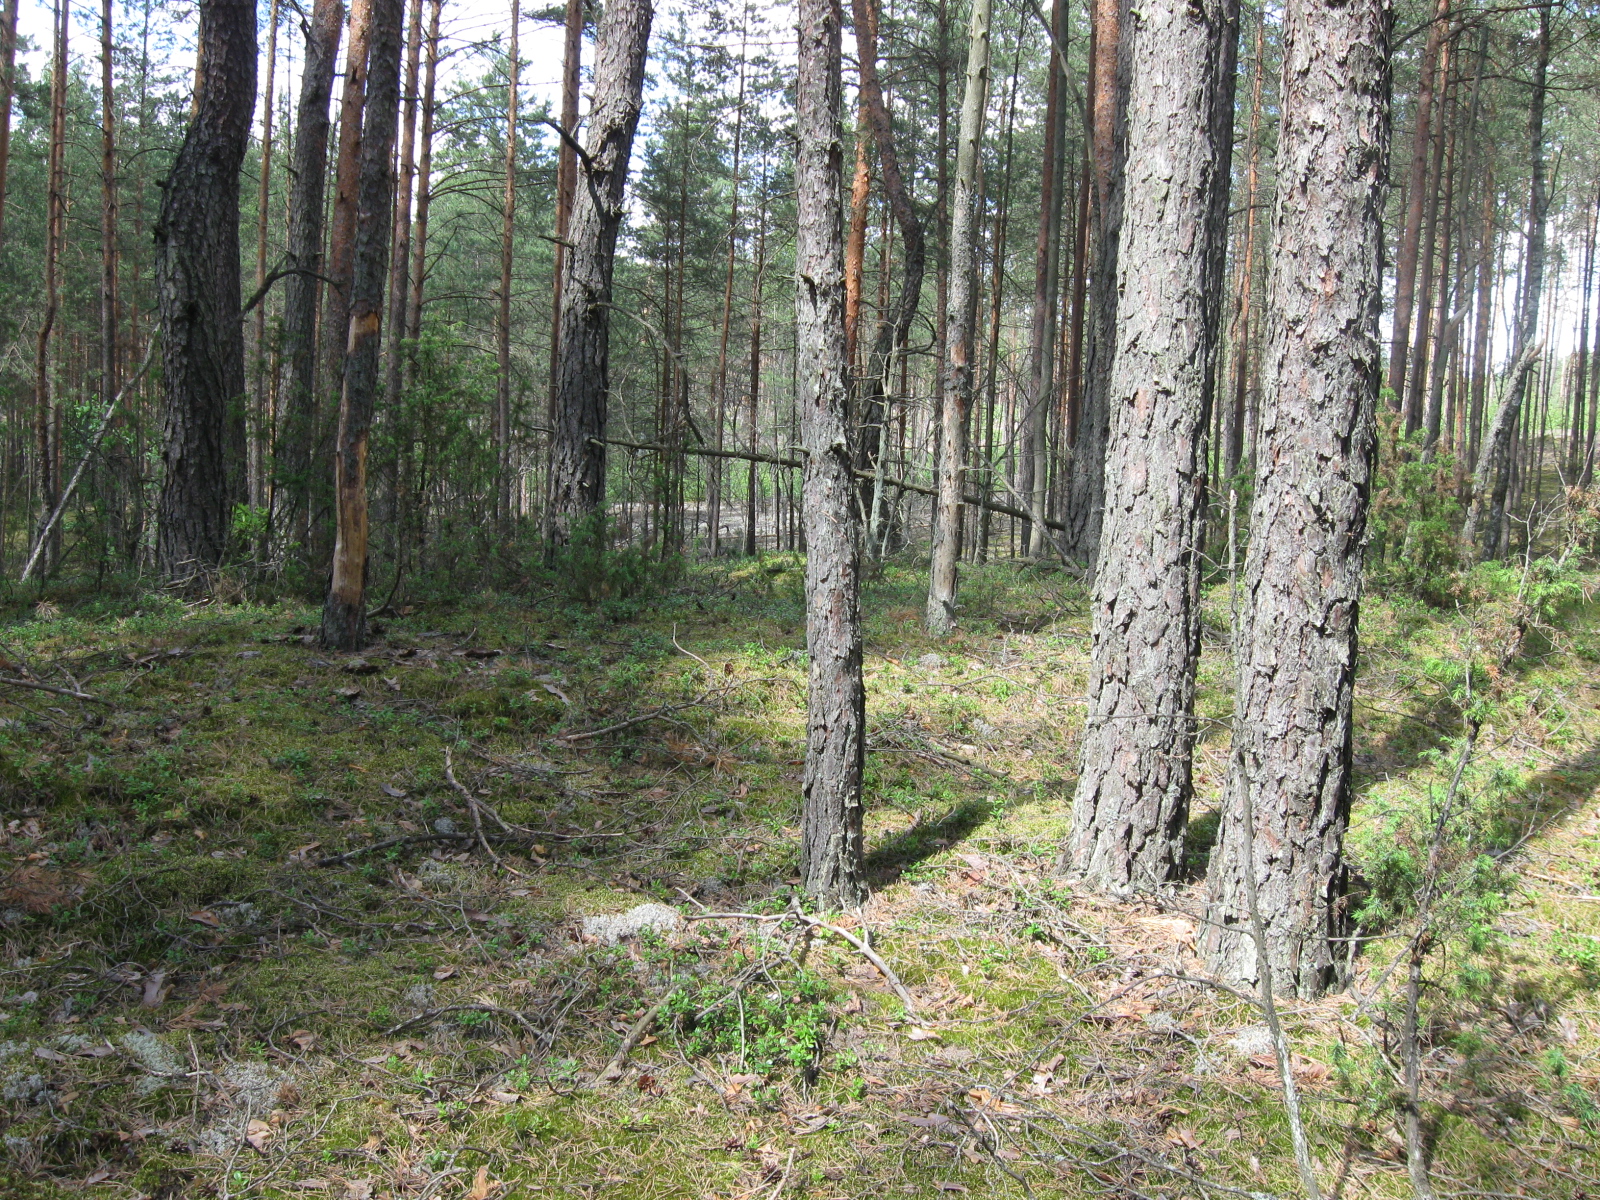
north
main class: Woodland
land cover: Pine dominated coniferous woodland
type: hemiboreal forest and nemoral coniferous forest and mixed broadleaved-coniferous forest
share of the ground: > 75 %
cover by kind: coniferous forest trees 95 %, lichens and mosses 5 %
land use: Forestry
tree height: > 5 m
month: June
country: LT
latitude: 54.0964
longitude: 24.4925
